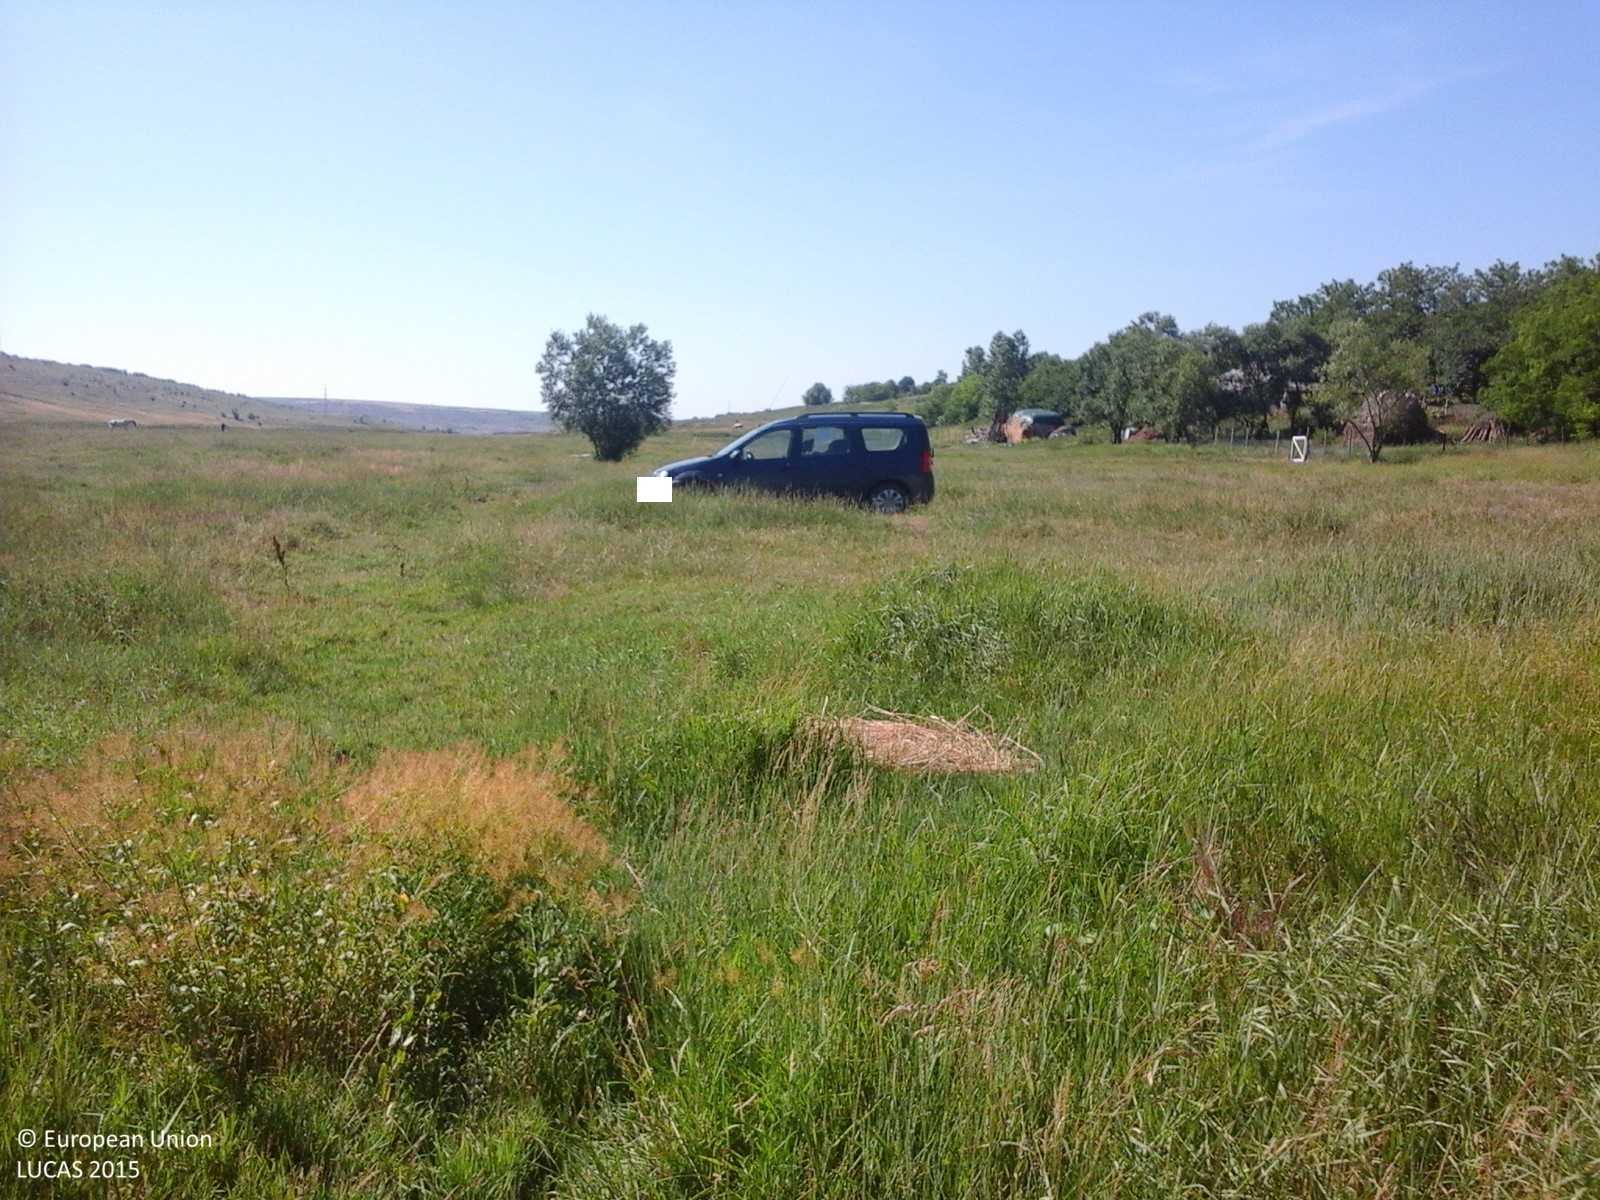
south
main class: Grassland
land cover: Grassland without tree/shrub cover
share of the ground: > 75 %
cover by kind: herbaceous plants 100 %
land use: Agriculture (excluding fallow land and kitchen gardens)
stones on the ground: < 10 %
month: June
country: RO
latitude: 47.7820
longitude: 26.8232
